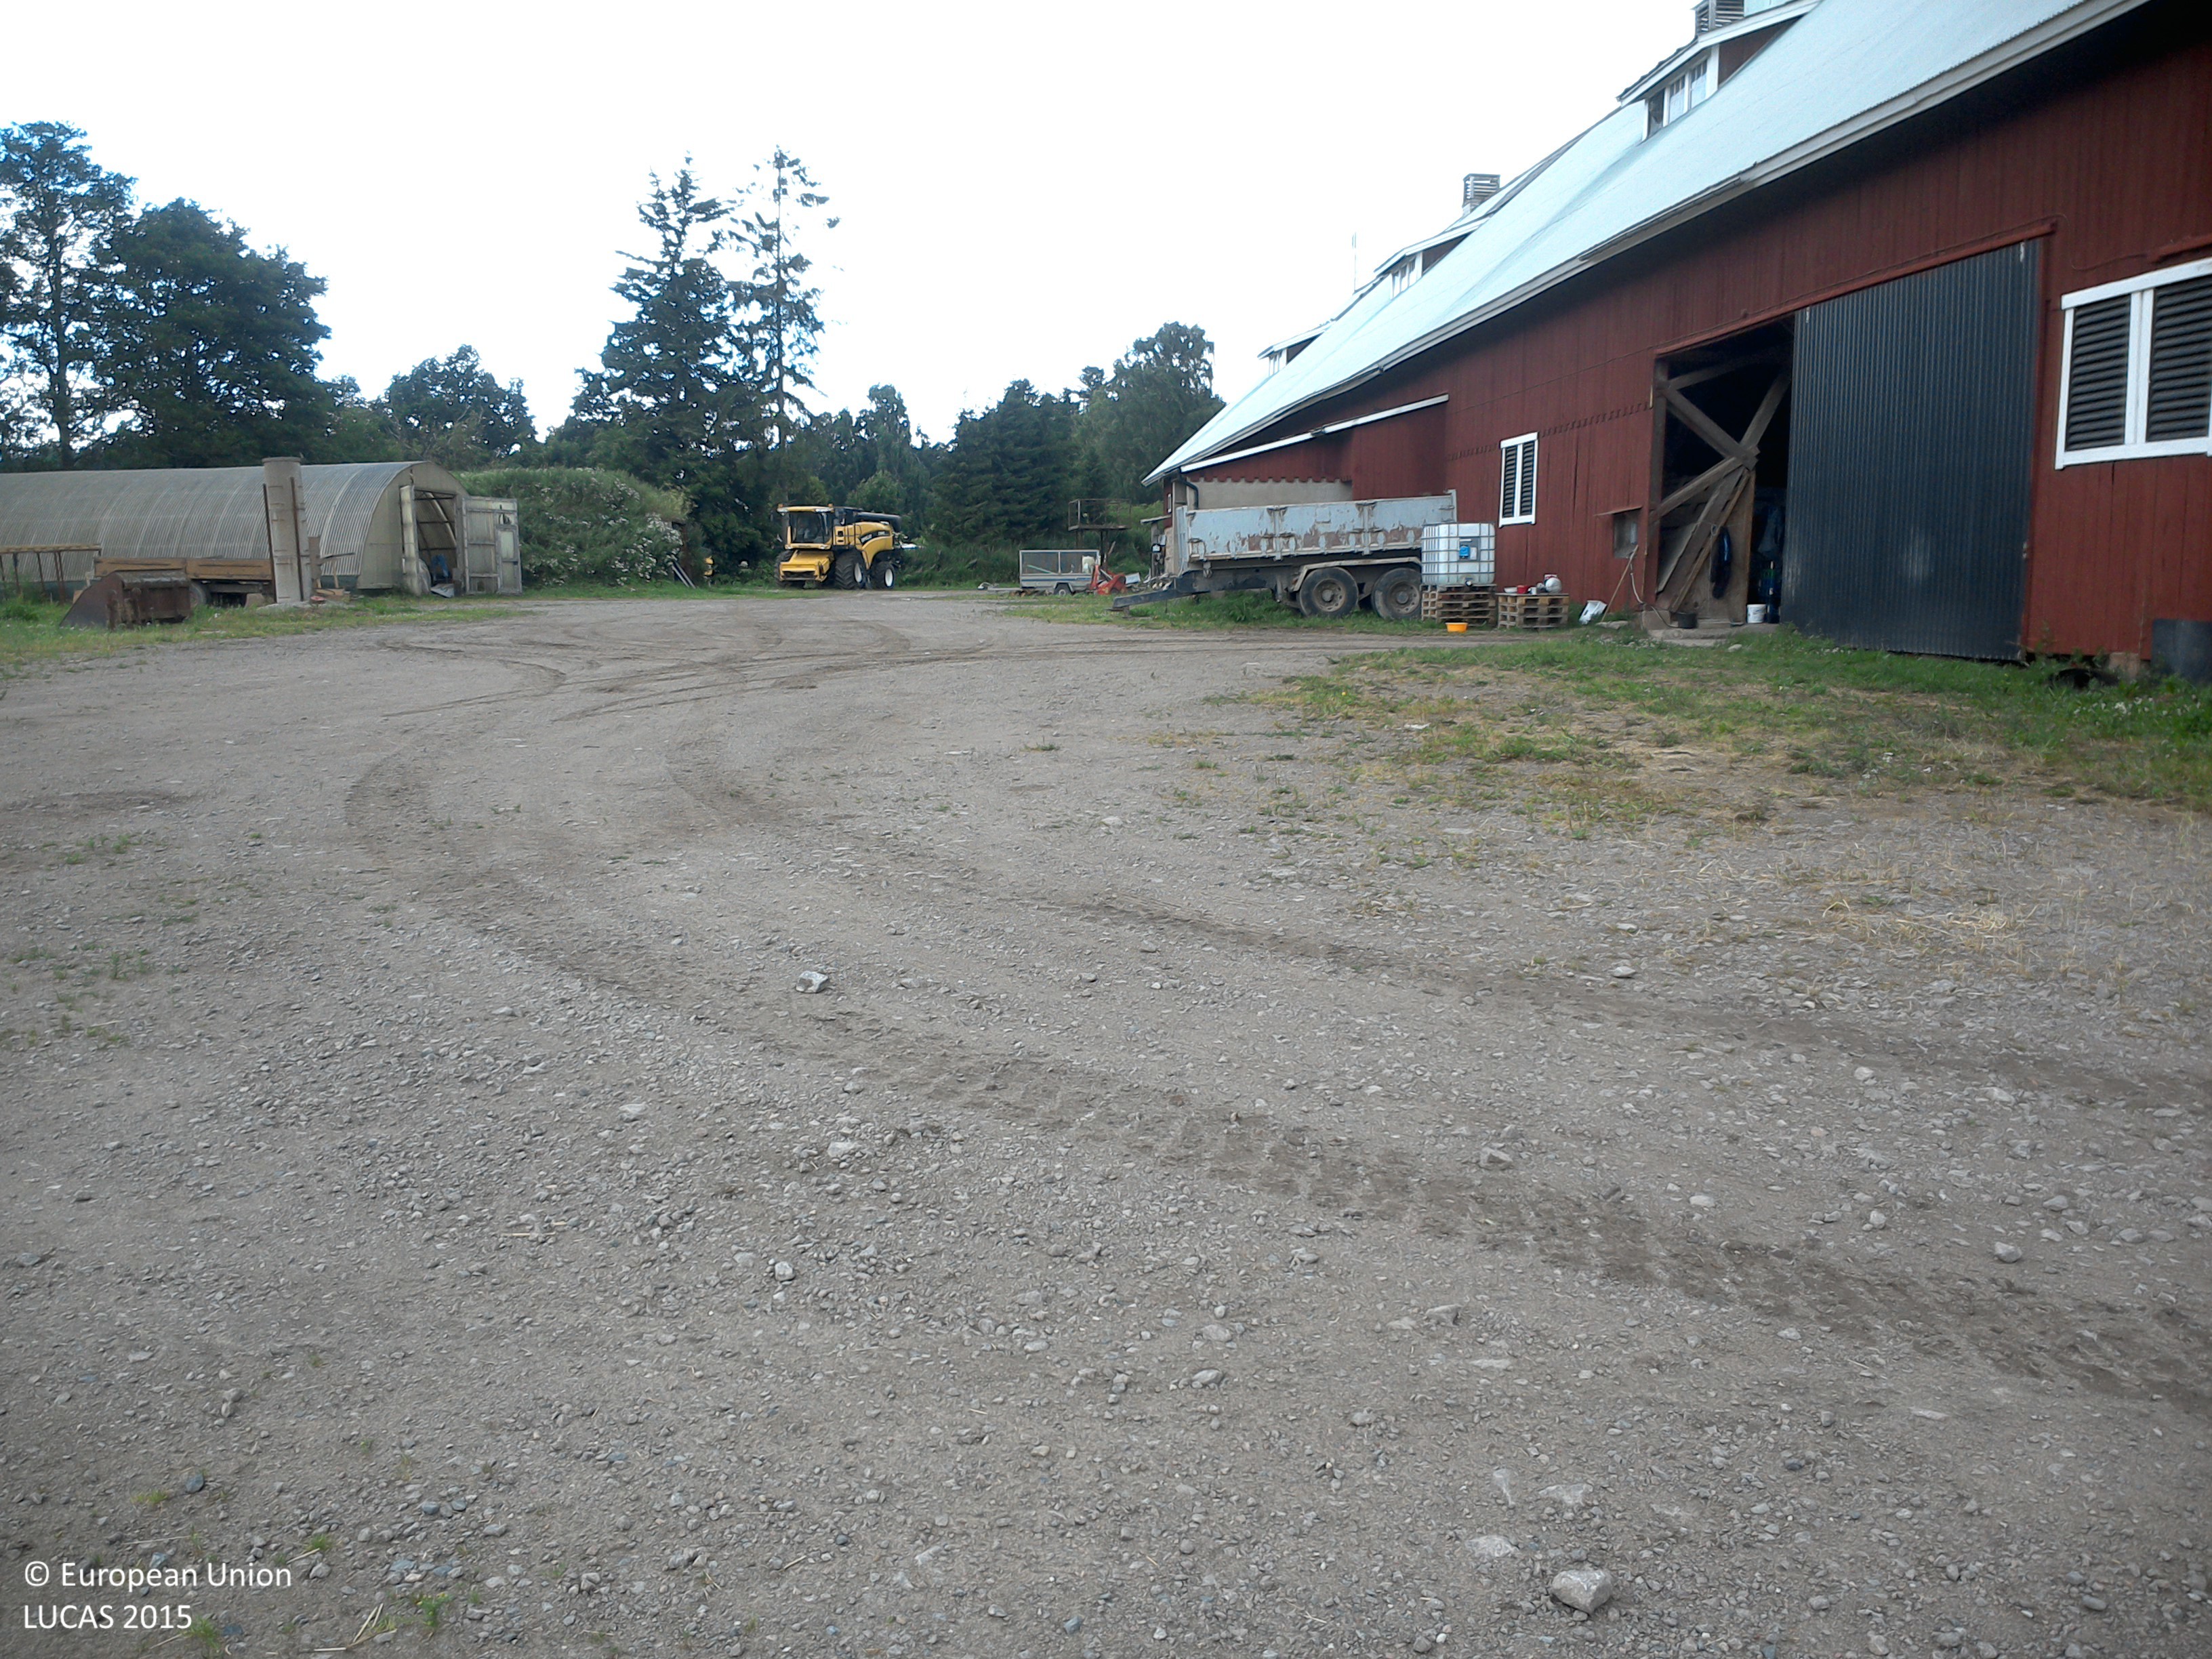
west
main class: Cropland
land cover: Rye
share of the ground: > 75 %
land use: Agriculture (excluding fallow land and kitchen gardens)
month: July
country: SE
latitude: 58.5773
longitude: 14.9978
